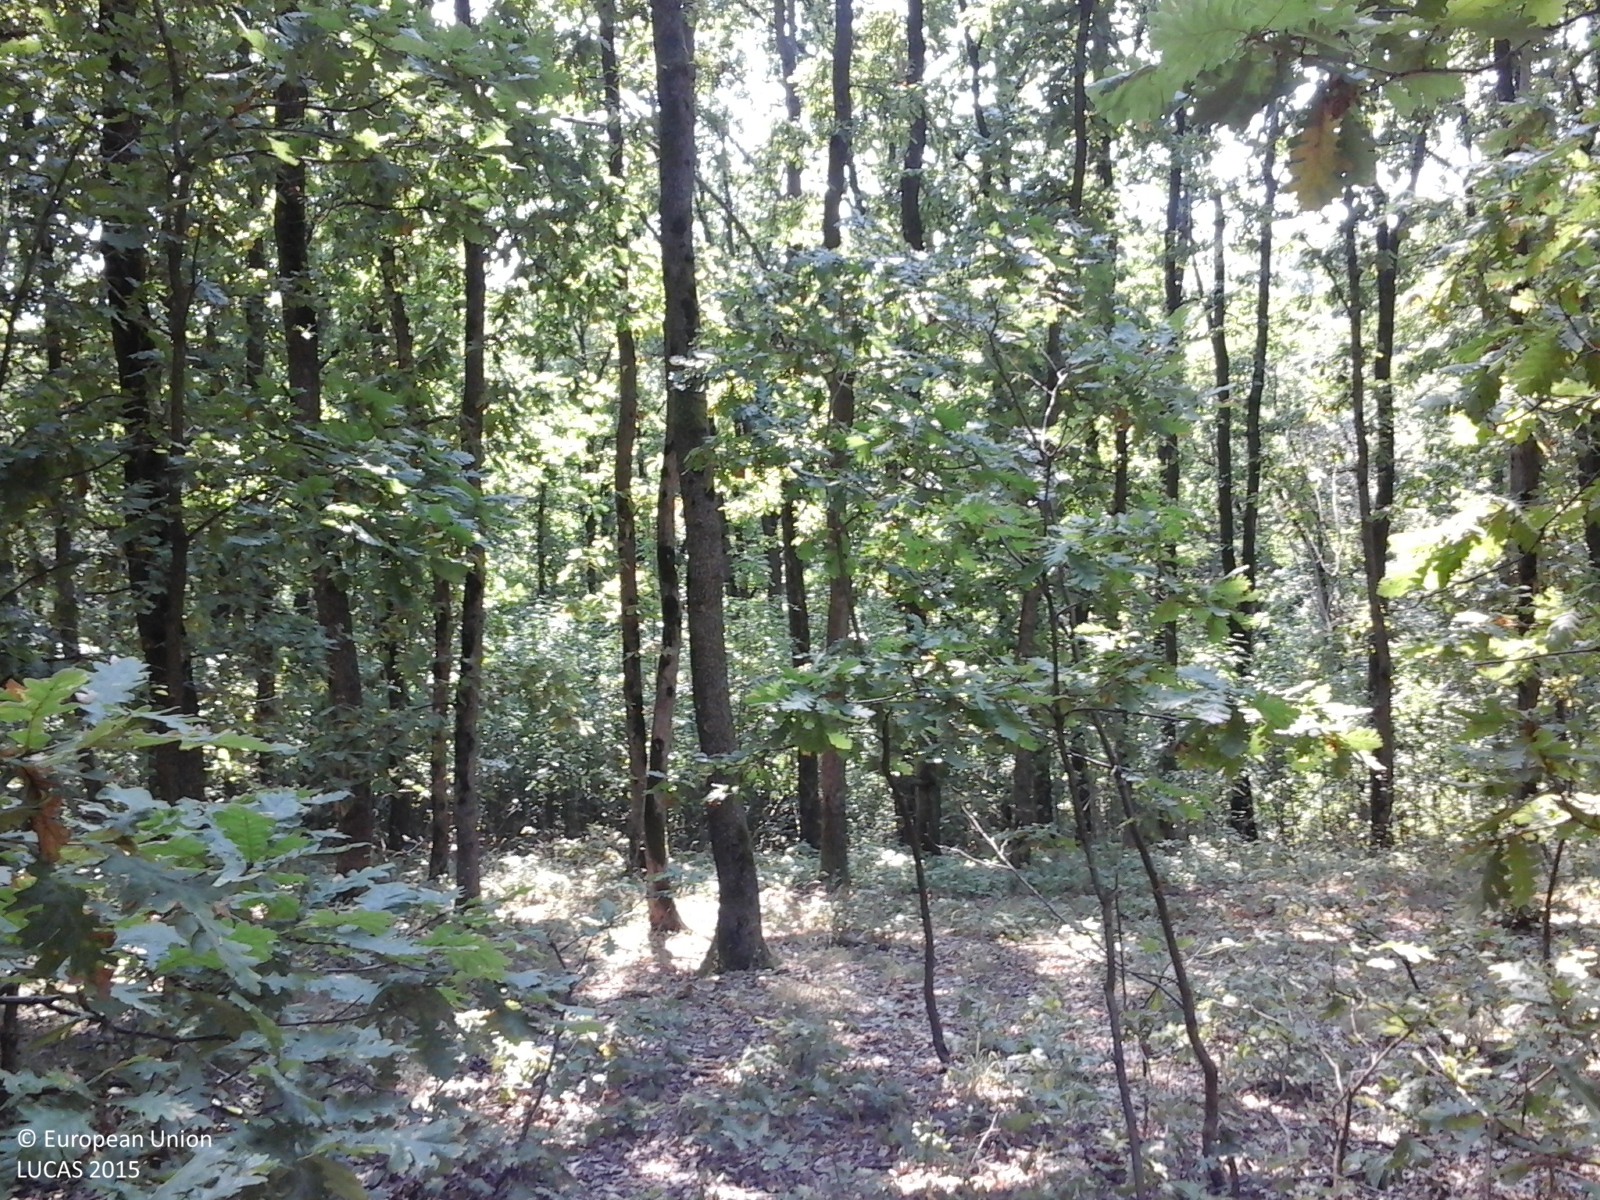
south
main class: Woodland
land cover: Broadleaved woodland
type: acidophilous oak and oak-birch forest
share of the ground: > 75 %
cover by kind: broadleaved forest trees 100 %
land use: Forestry
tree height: > 5 m
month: August
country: RO
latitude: 44.5082
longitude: 23.4745
